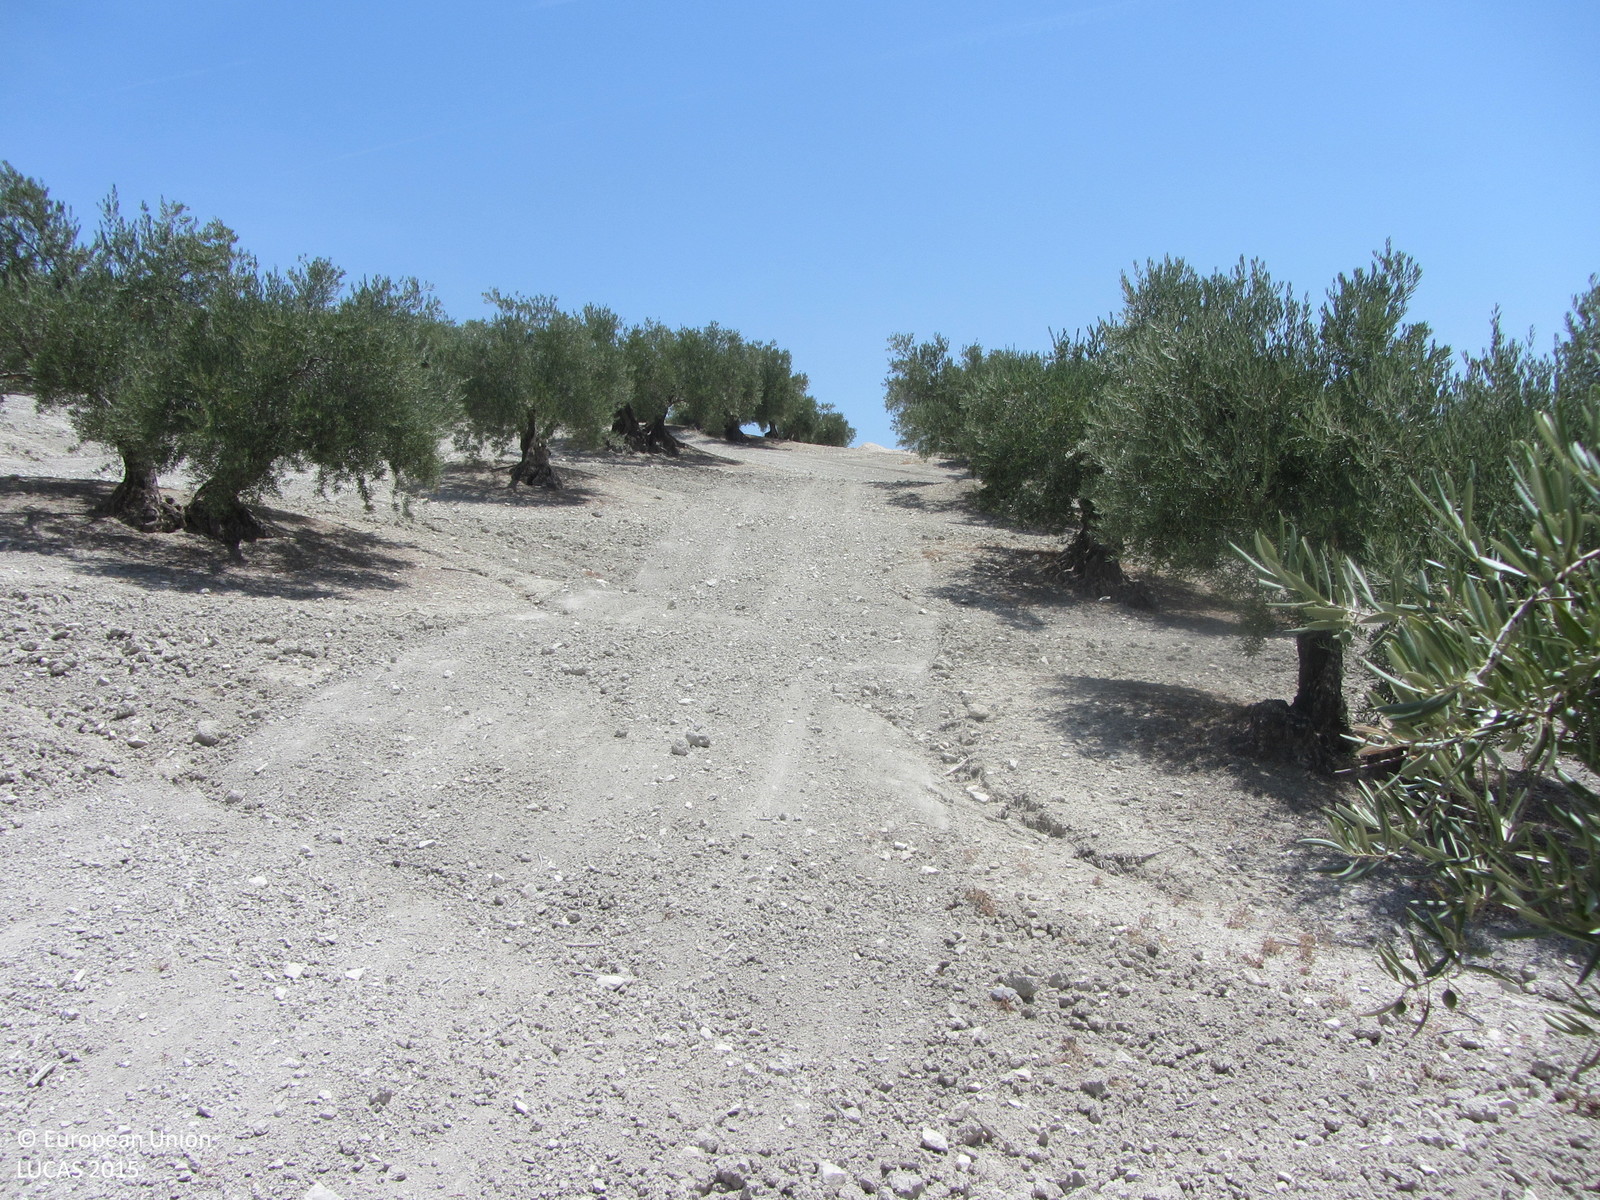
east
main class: Cropland
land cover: Olive groves
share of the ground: 25 - 50 %
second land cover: Other bare soil
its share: > 75 %
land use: Agriculture (excluding fallow land and kitchen gardens)
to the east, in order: Olive groves; Other bare soil; Tracks; Ditches and canals; Olive groves; Other structural elements; Olive groves
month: July
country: ES
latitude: 37.7484
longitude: -4.1569
